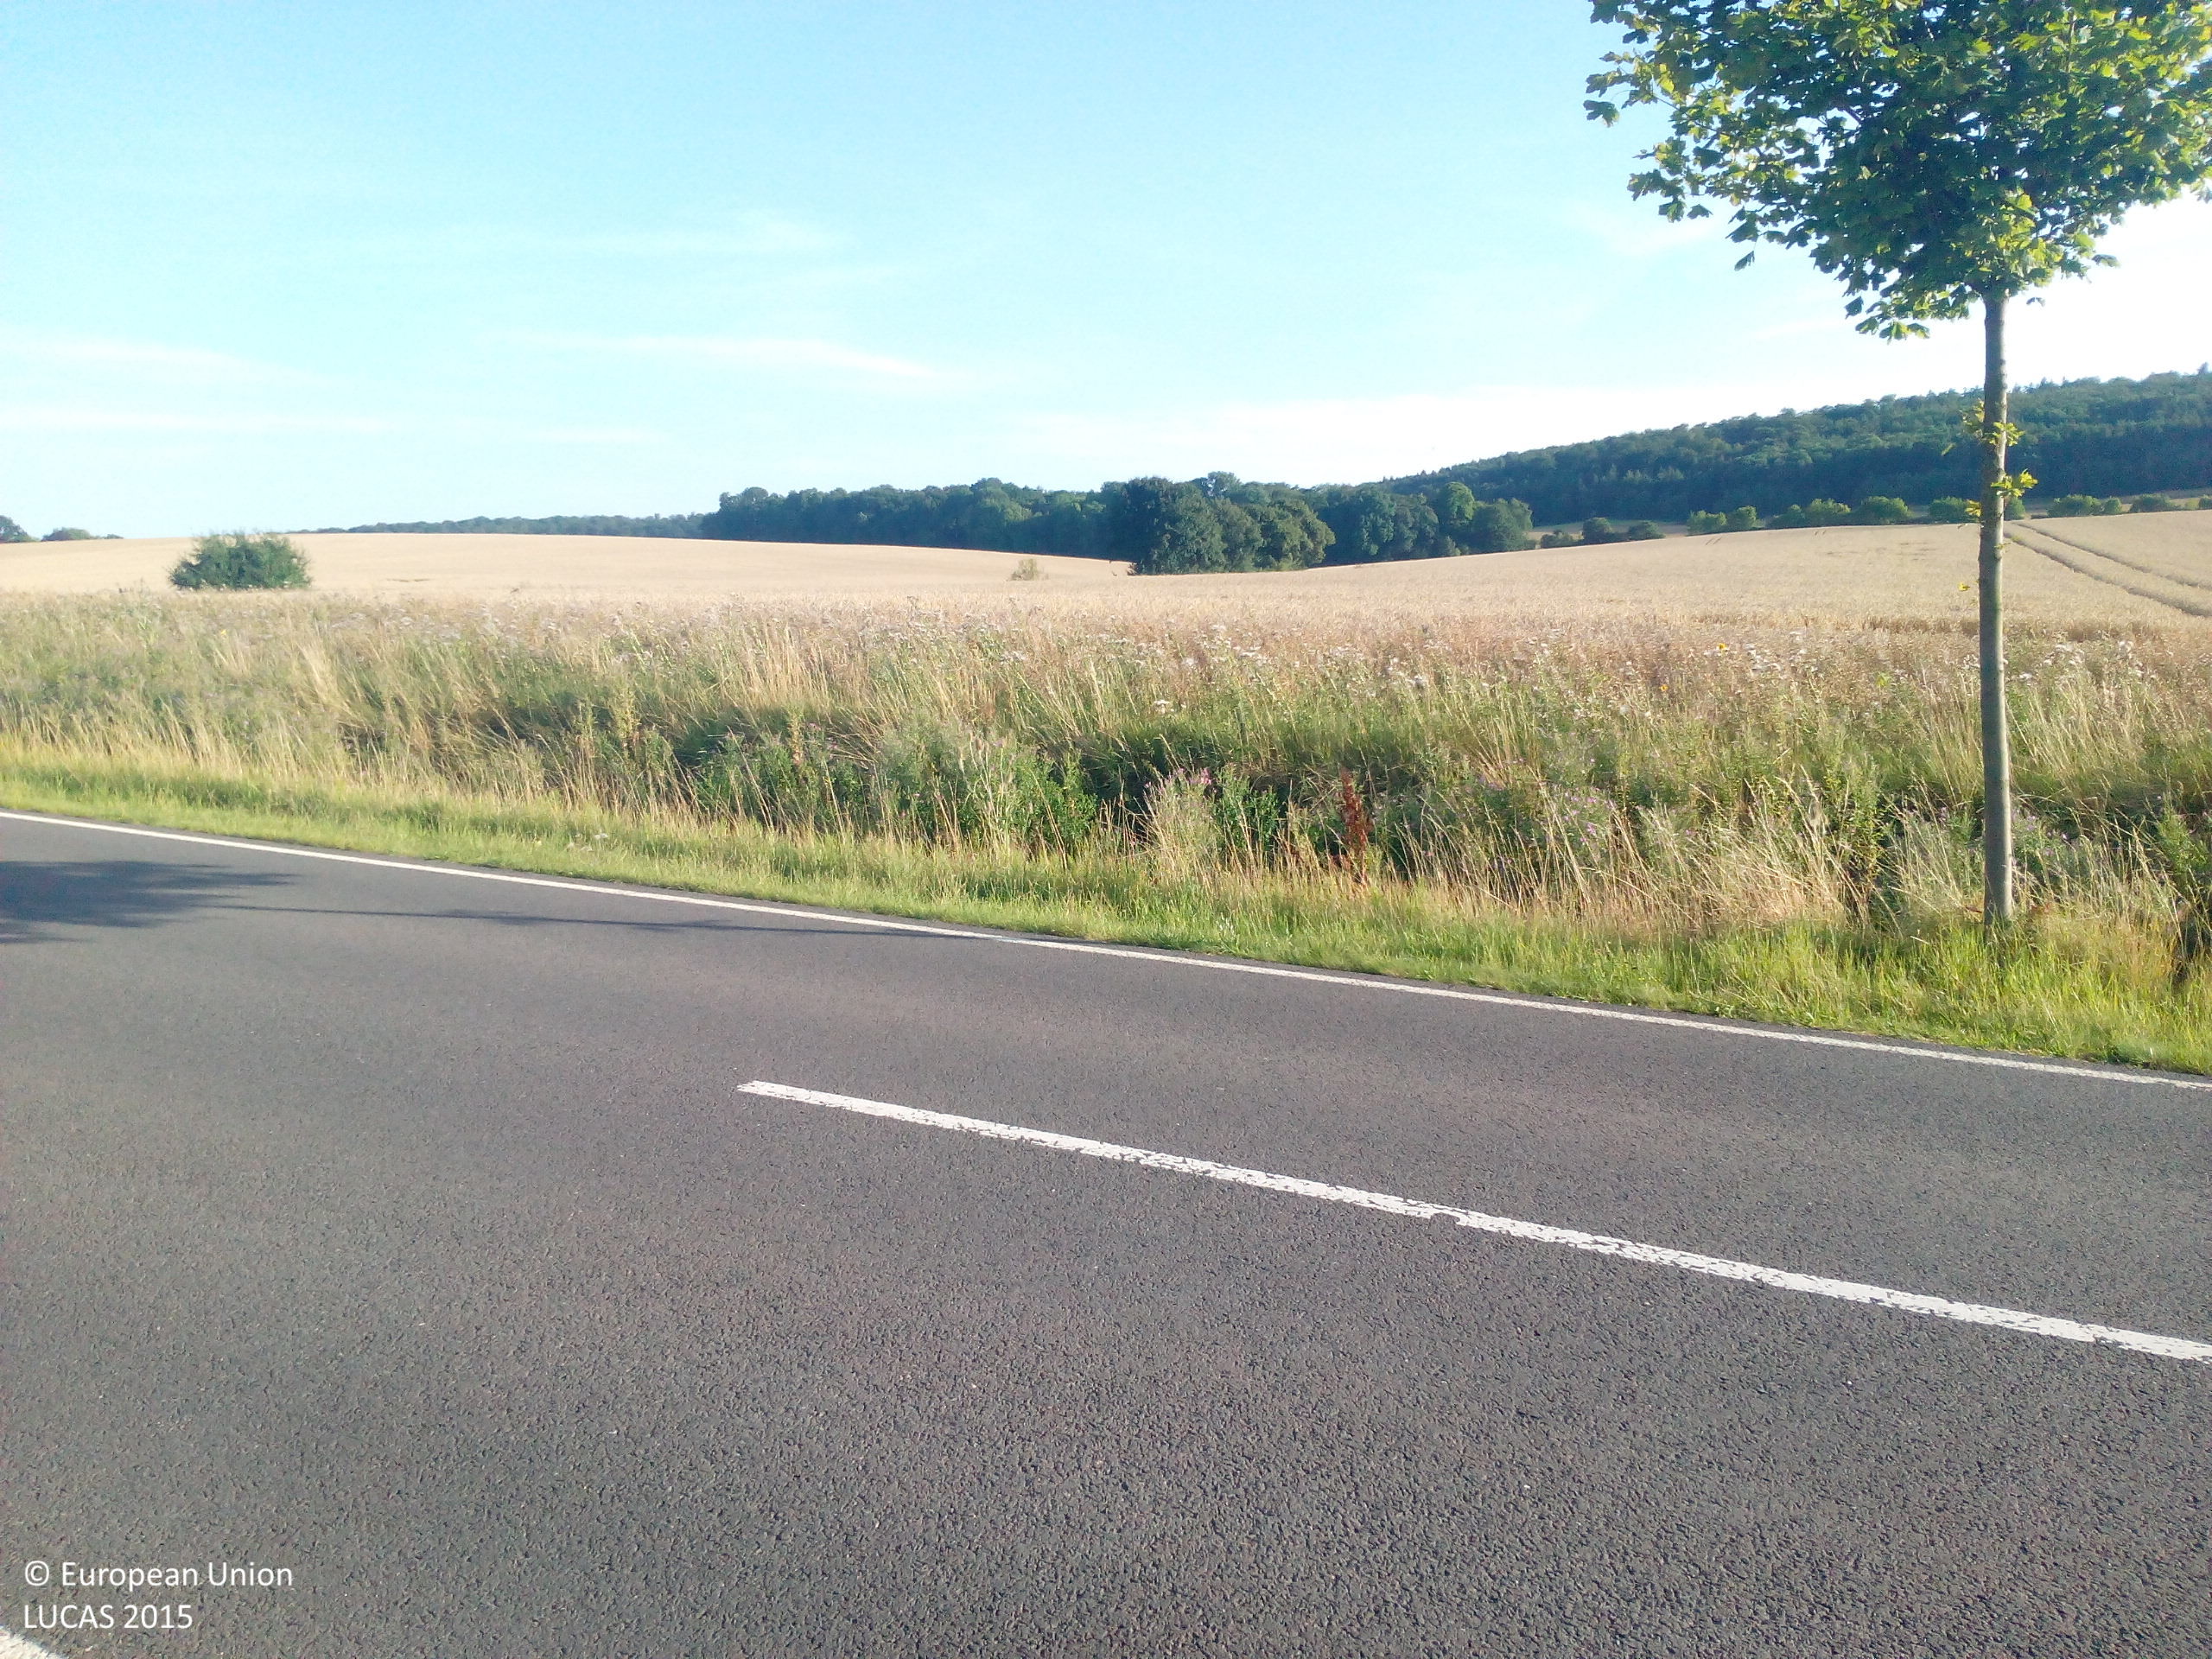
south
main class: Cropland
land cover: Common wheat
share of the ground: > 75 %
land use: Agriculture (excluding fallow land and kitchen gardens)
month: August
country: DE
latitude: 52.1418
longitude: 10.6865
